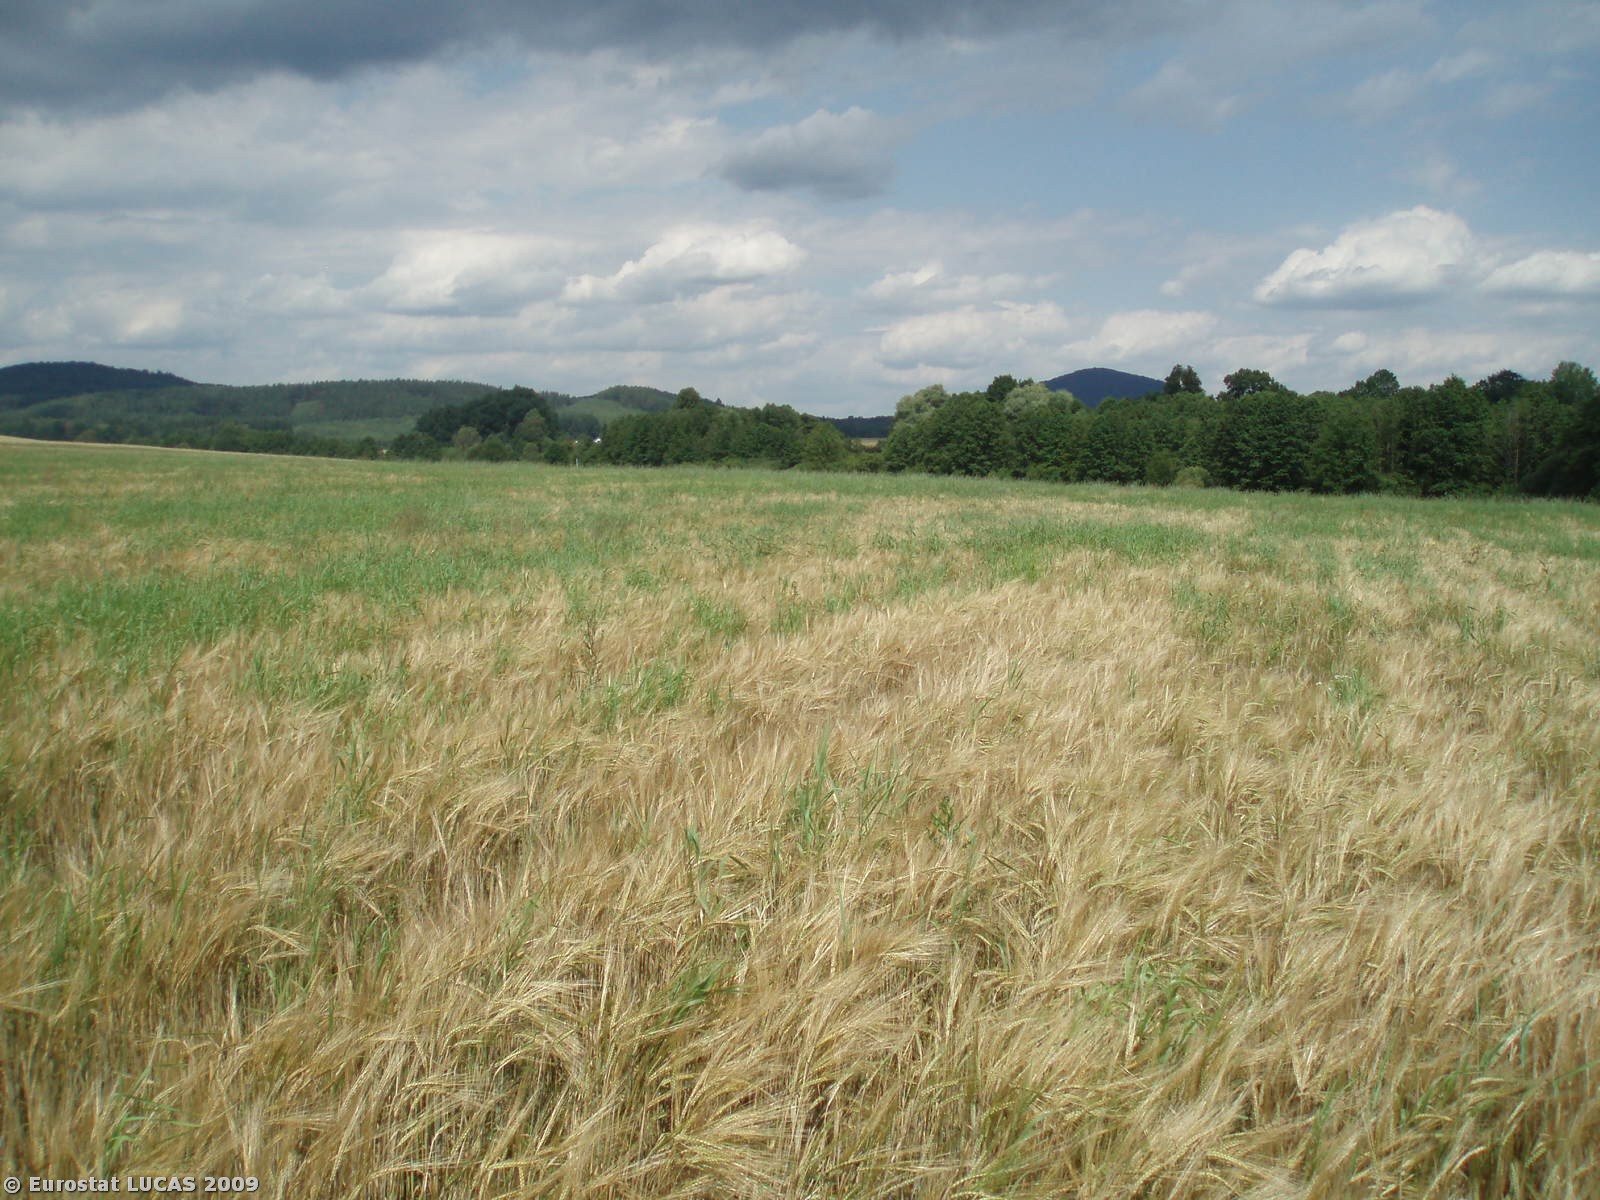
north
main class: Cropland
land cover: Barley
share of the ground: > 75 %
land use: Agriculture (excluding fallow land and kitchen gardens)
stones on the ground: < 10 %
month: July
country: CZ
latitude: 50.7350
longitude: 14.7205
